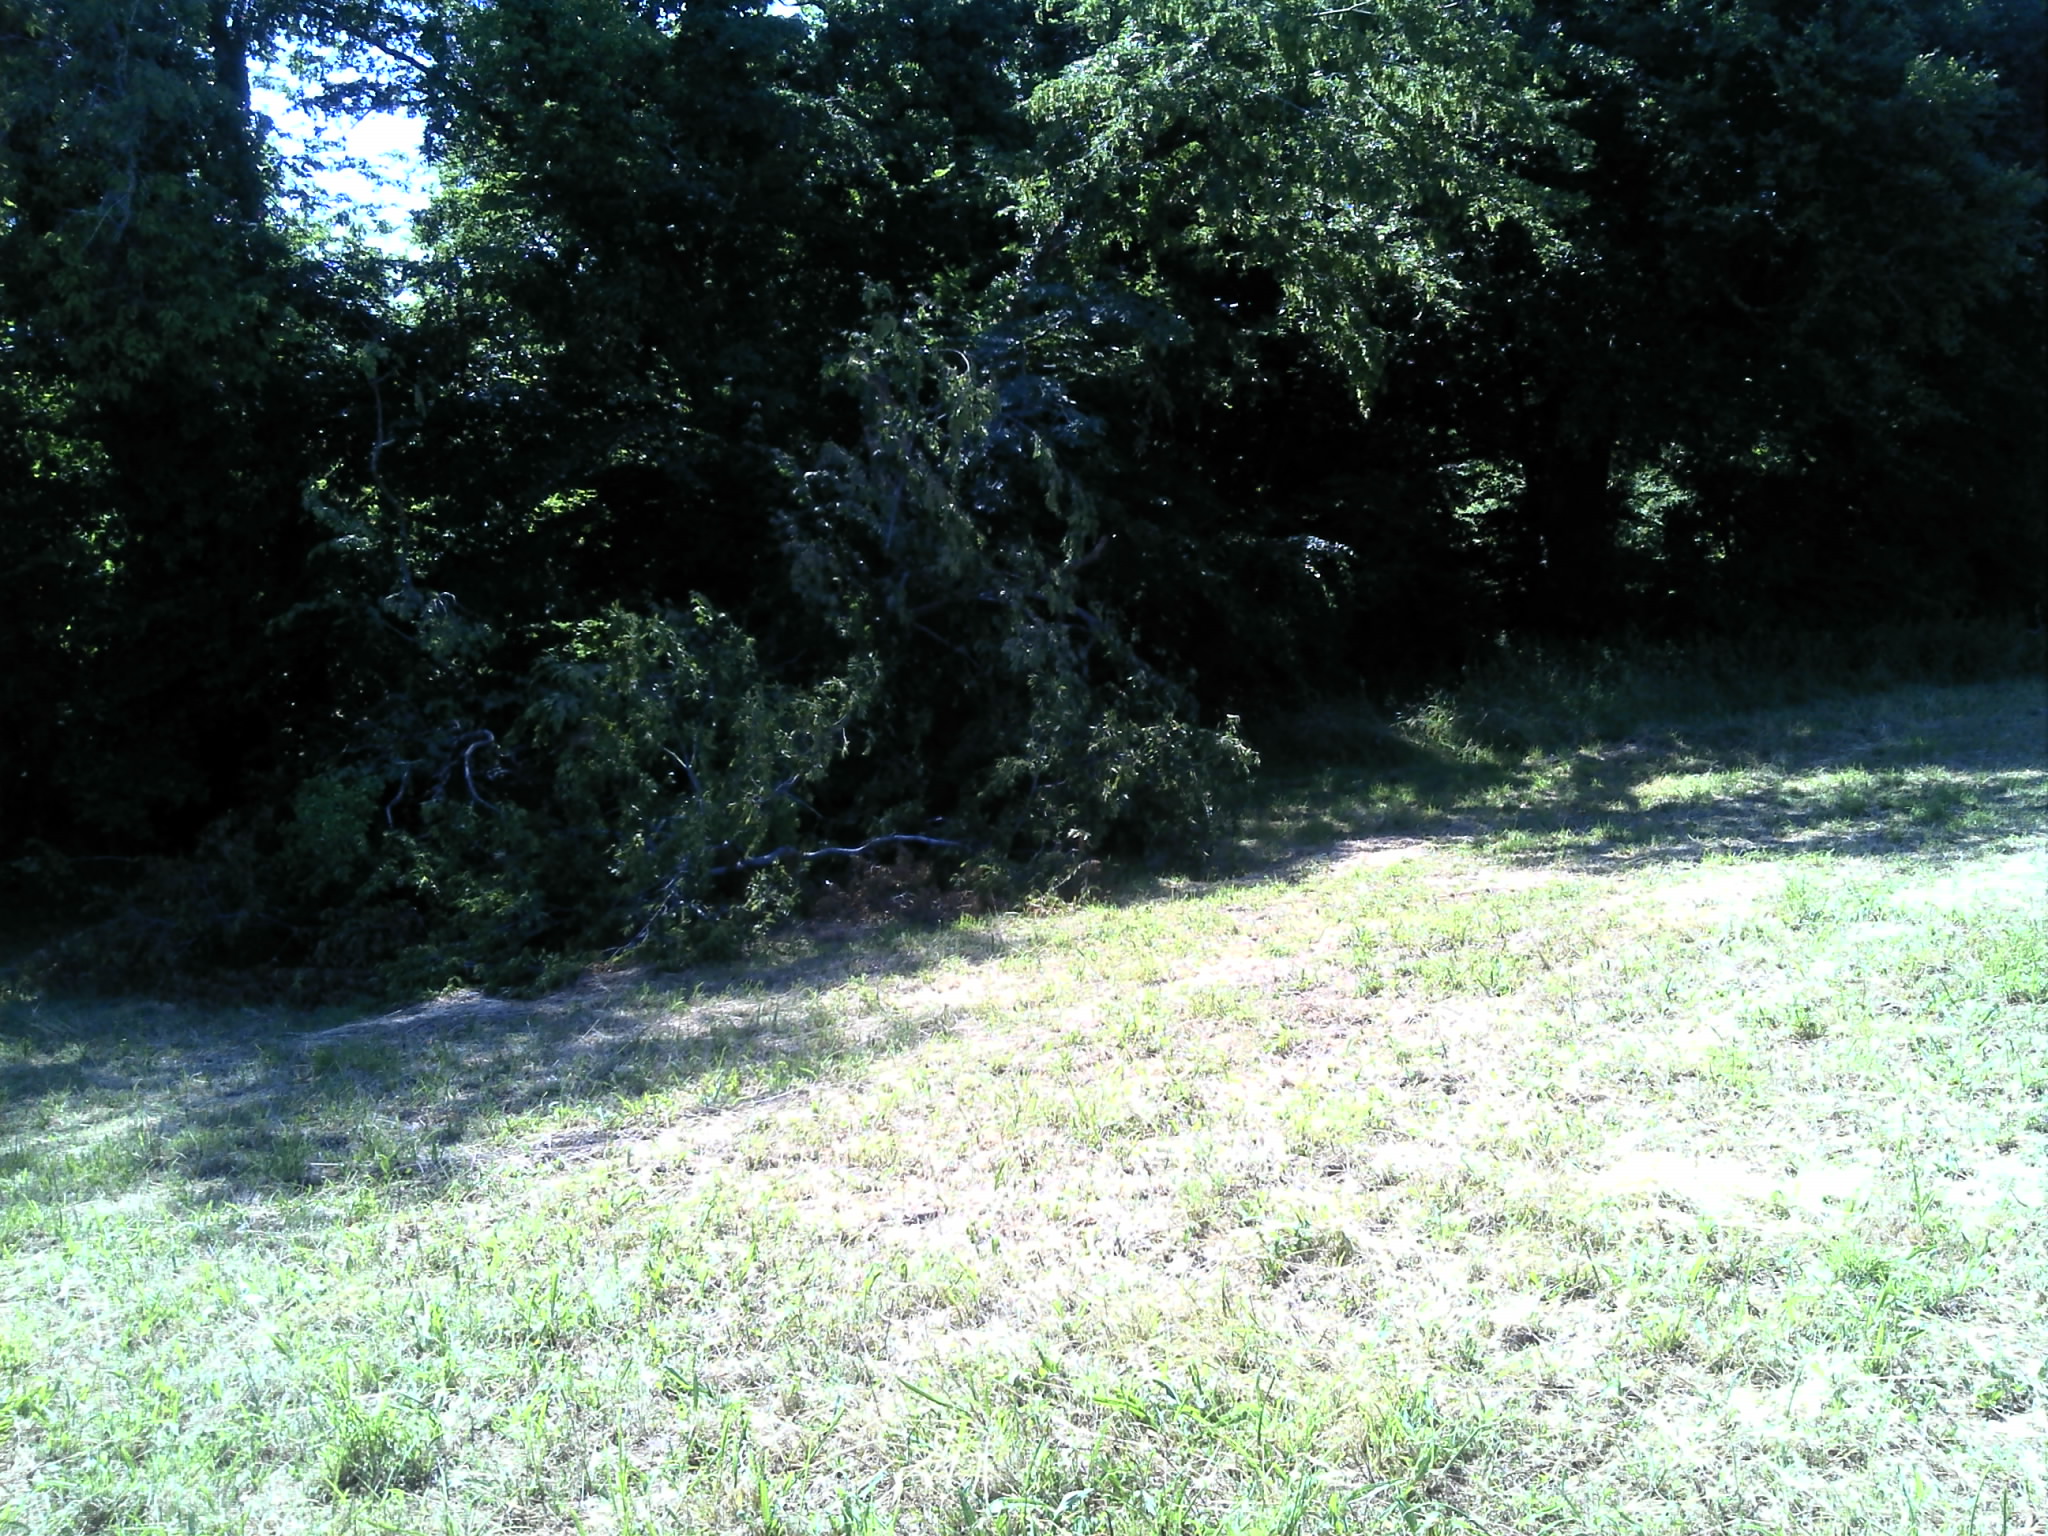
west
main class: Grassland
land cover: Grassland without tree/shrub cover
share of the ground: > 75 %
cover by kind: herbaceous plants 100 %
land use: Agriculture (excluding fallow land and kitchen gardens)
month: June
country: FR
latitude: 46.4303
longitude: 1.5182
